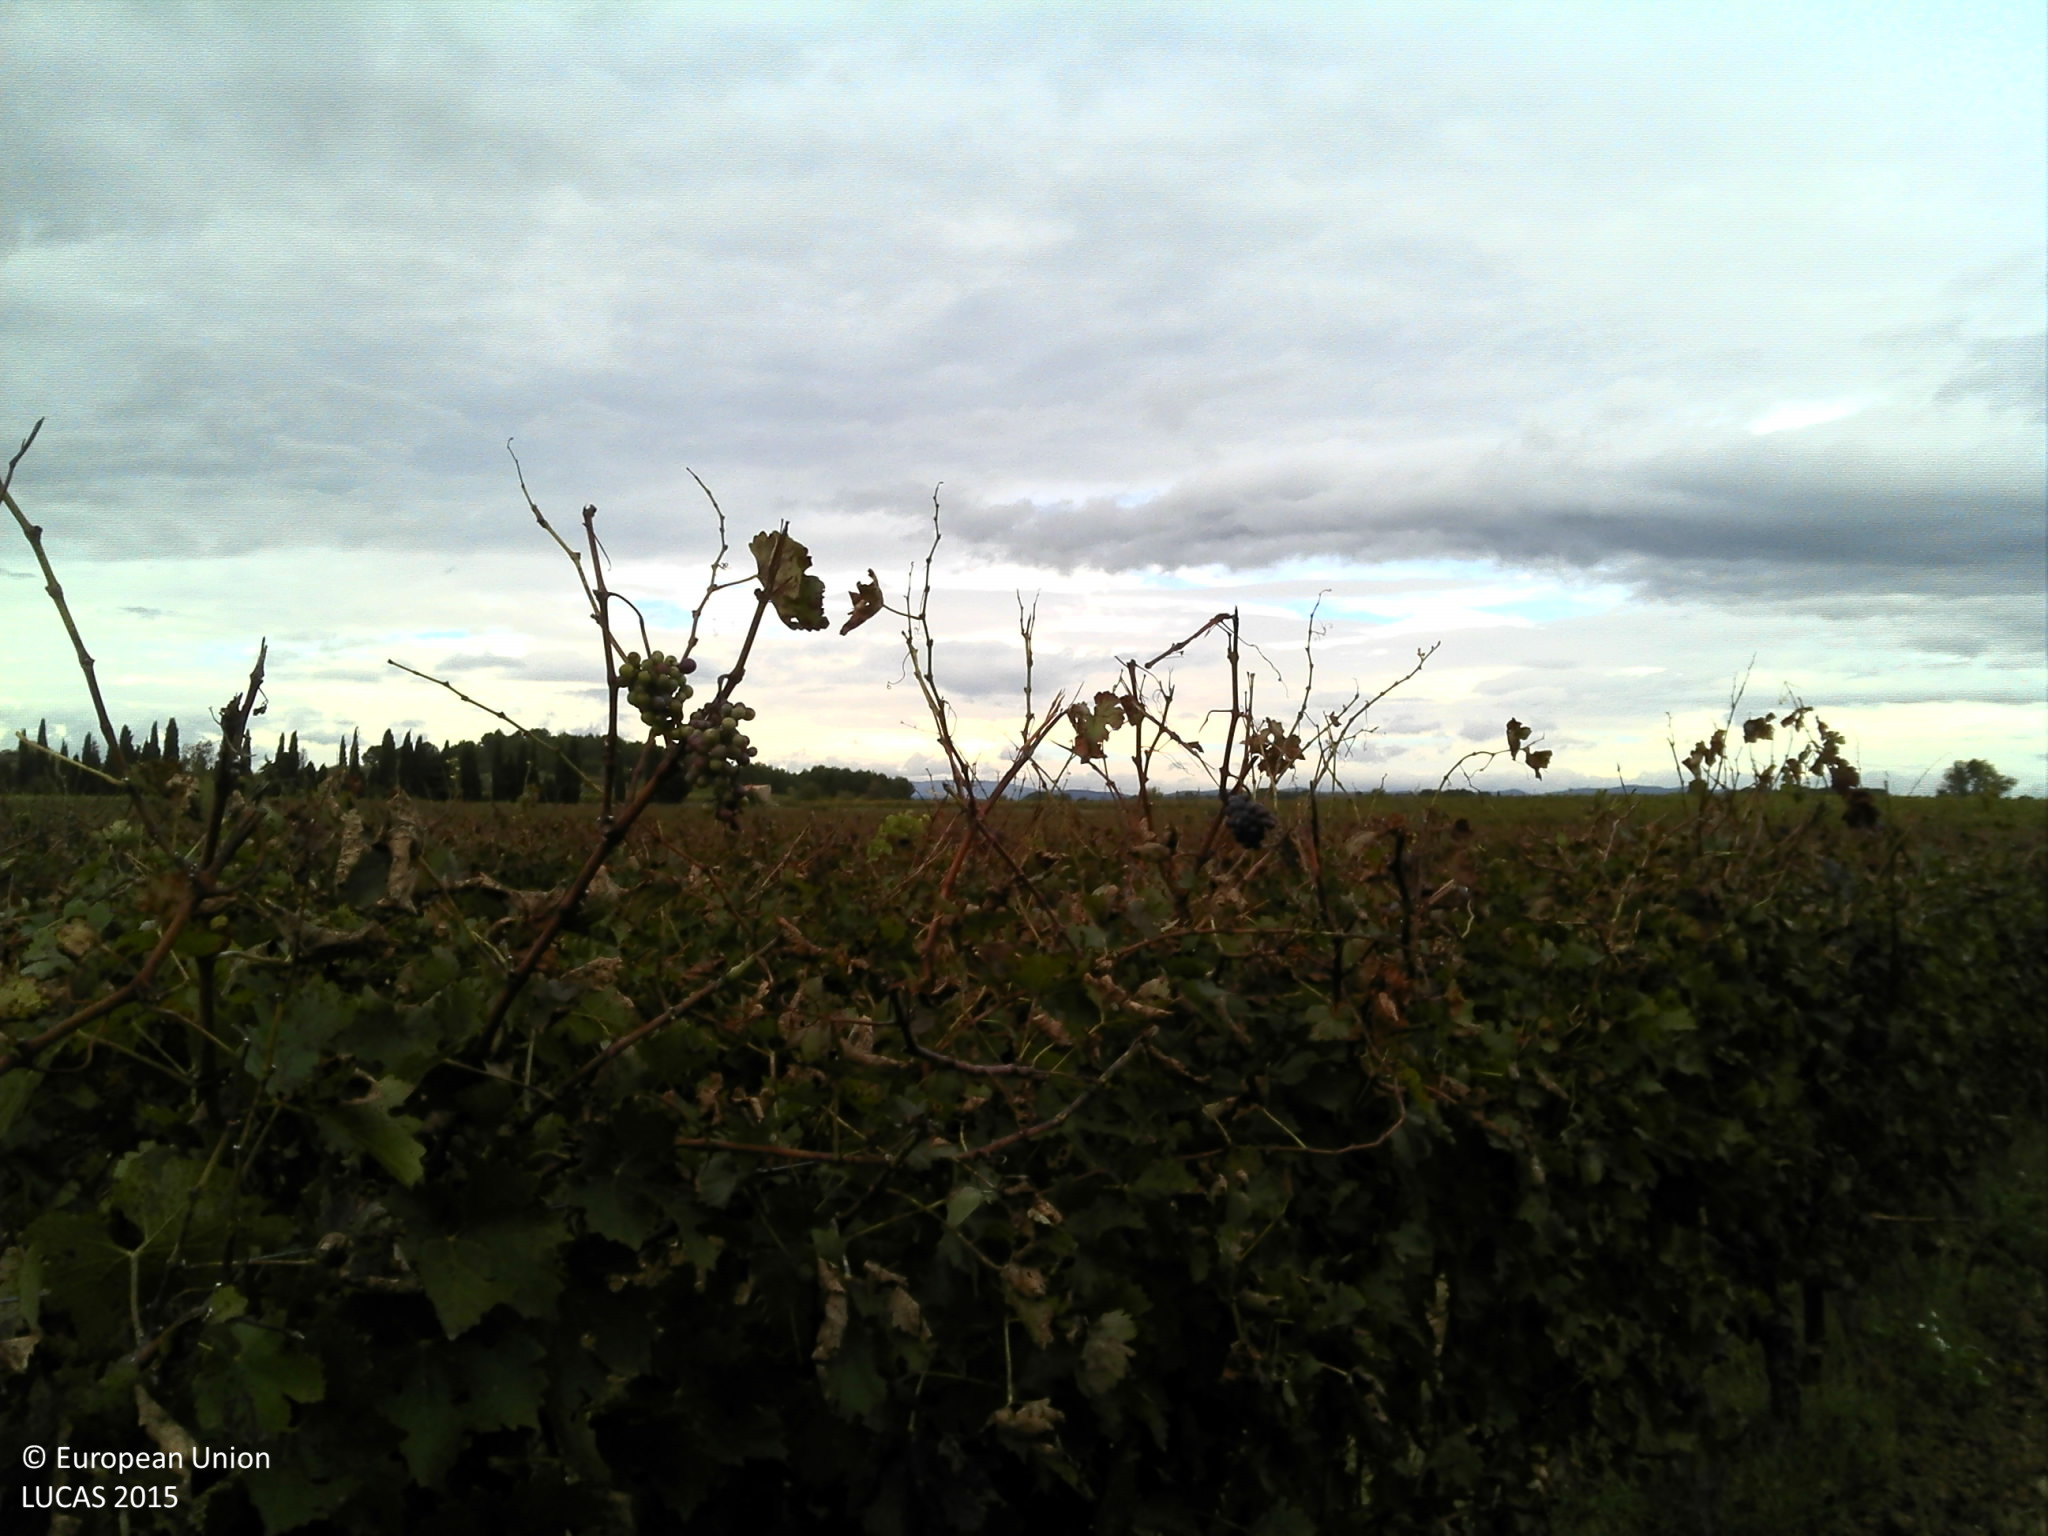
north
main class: Cropland
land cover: Vineyards
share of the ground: 10 - 25 %
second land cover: Other bare soil
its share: > 75 %
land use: Agriculture (excluding fallow land and kitchen gardens)
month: October
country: FR
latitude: 43.3596
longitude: 3.0870
